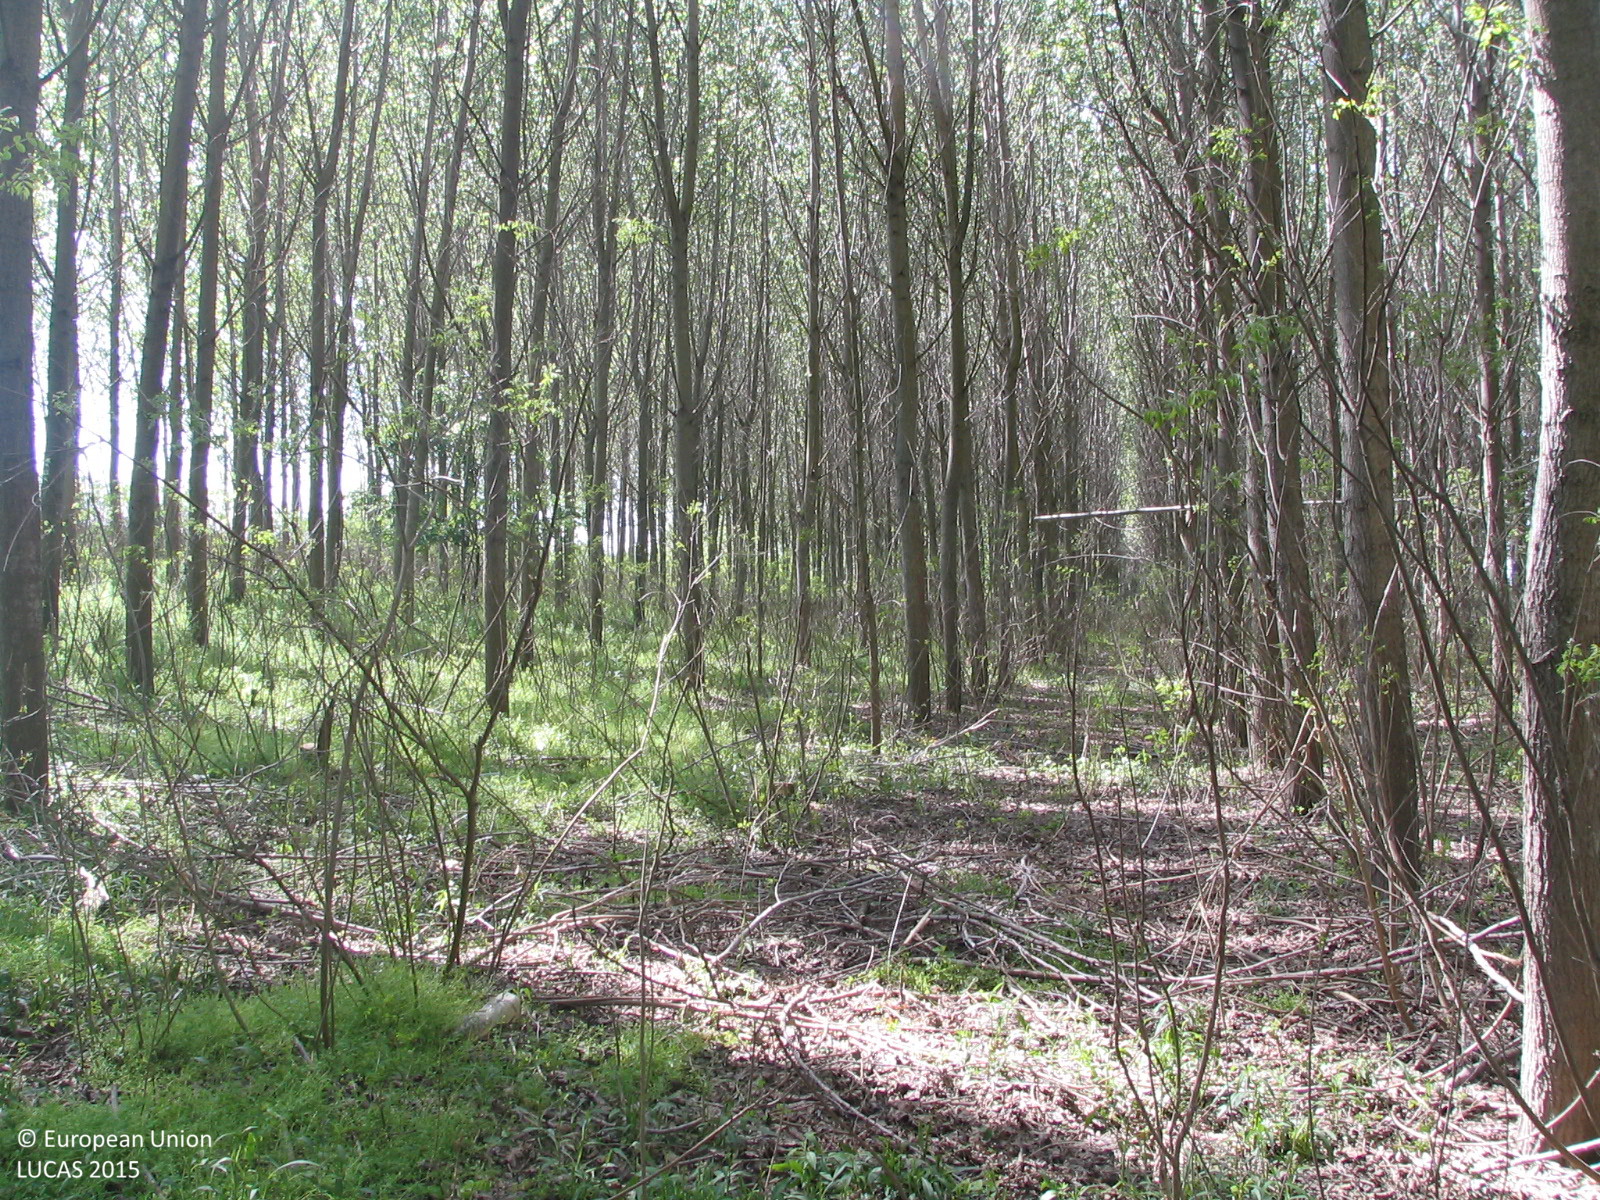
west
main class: Woodland
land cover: Broadleaved woodland
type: floodplain forest
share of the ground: > 75 %
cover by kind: broadleaved forest trees 90 %, shrubs 5 %, herbaceous plants 5 %
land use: Forestry
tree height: > 5 m
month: May
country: BG
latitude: 43.6879
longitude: 24.1378
